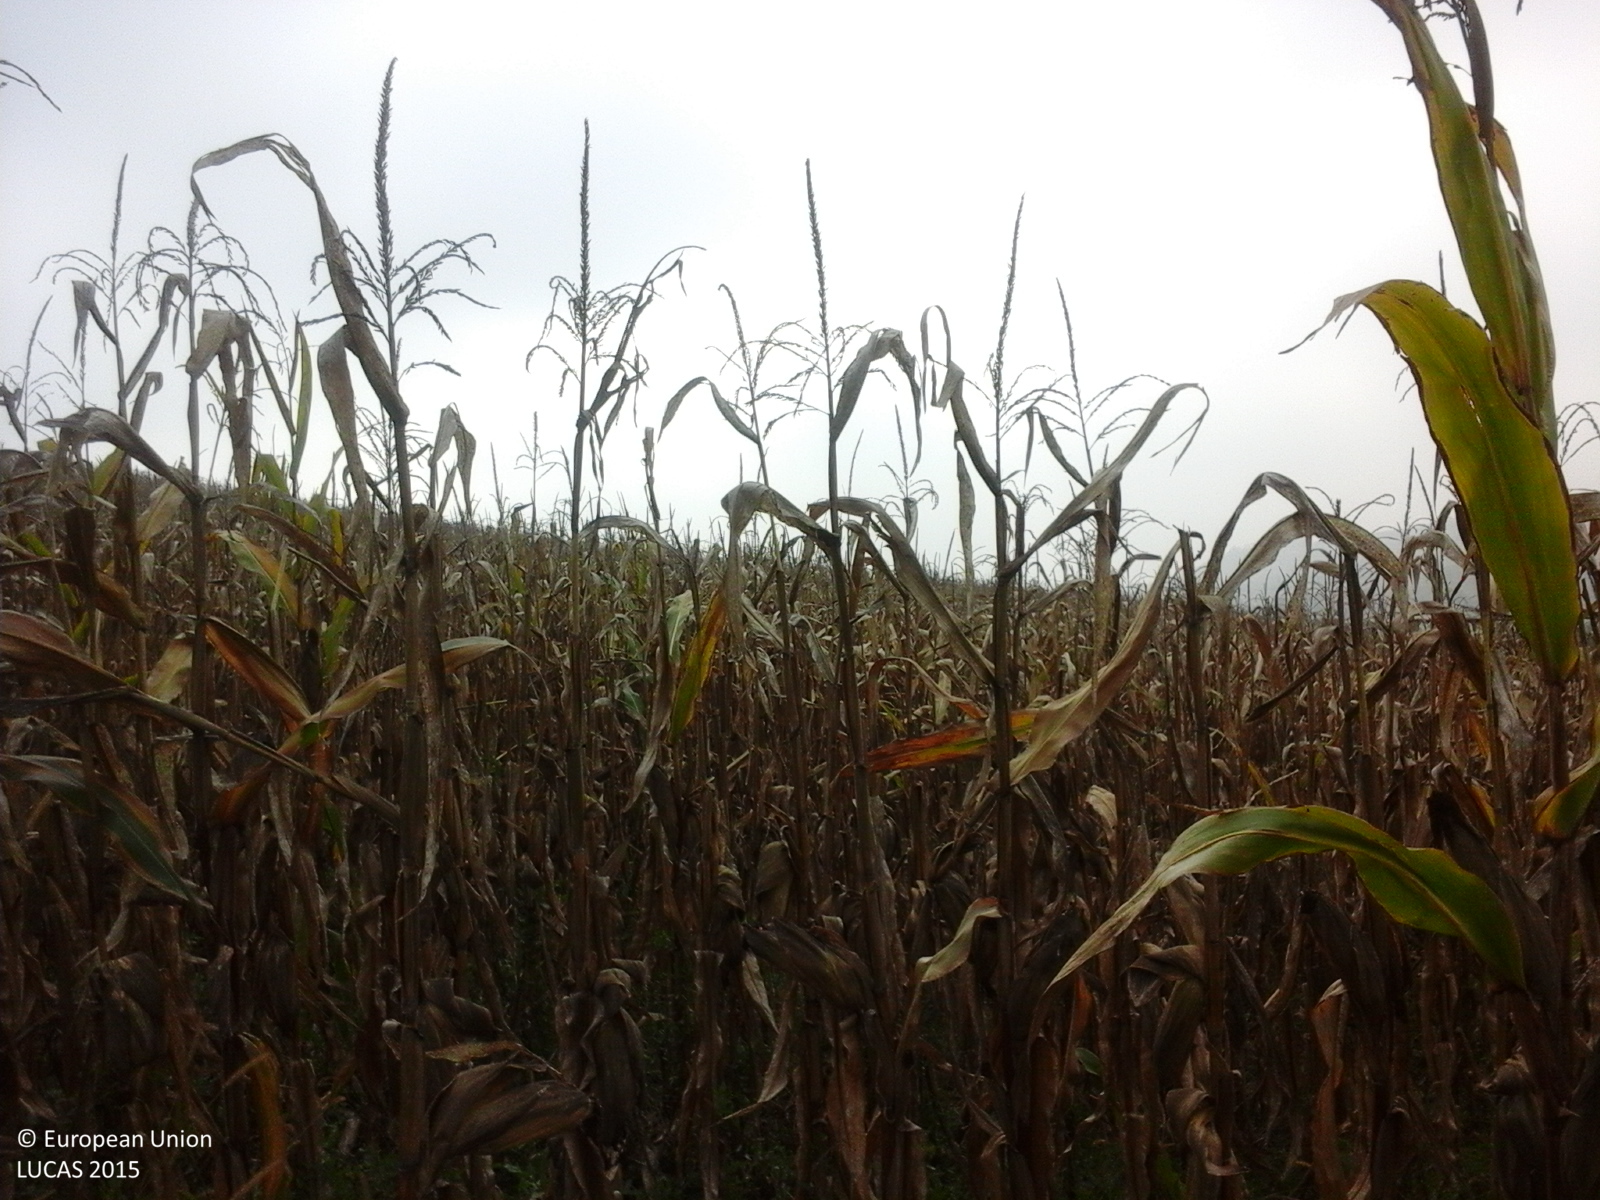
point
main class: Cropland
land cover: Maize
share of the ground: > 75 %
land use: Agriculture (excluding fallow land and kitchen gardens)
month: October
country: RO
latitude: 46.6018
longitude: 24.3532
